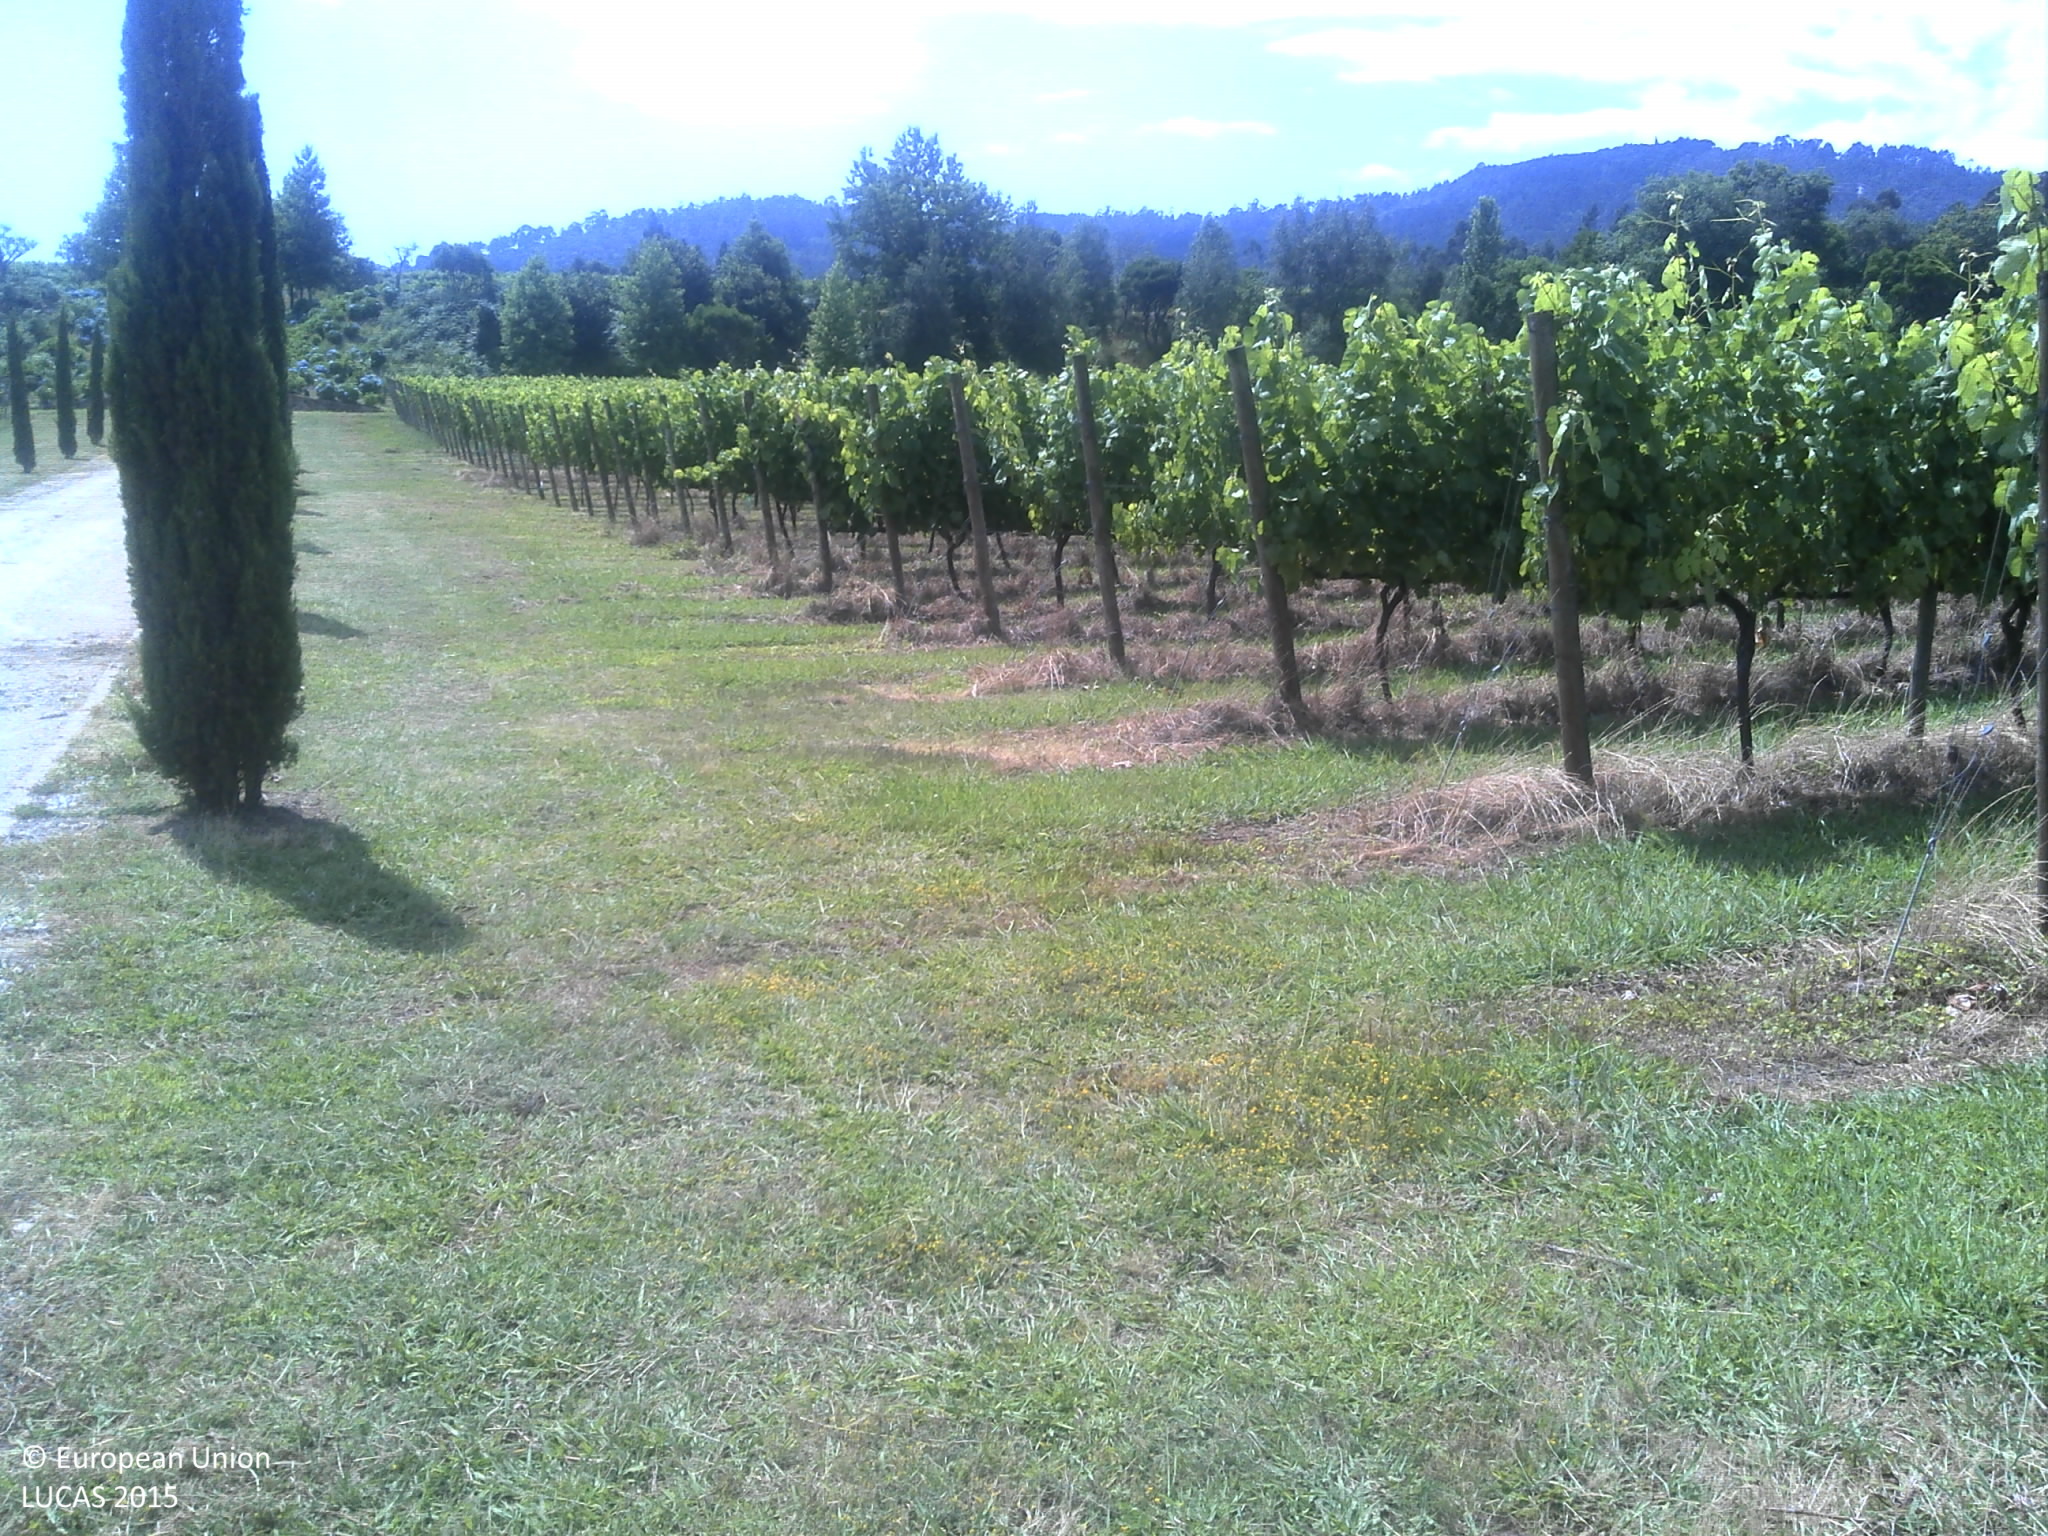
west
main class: Grassland
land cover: Grassland without tree/shrub cover
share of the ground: > 75 %
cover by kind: herbaceous plants 85 %, unconsolidated bare surface 15 %
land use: Agriculture (excluding fallow land and kitchen gardens)
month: June
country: PT
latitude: 41.5710
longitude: -8.5423
